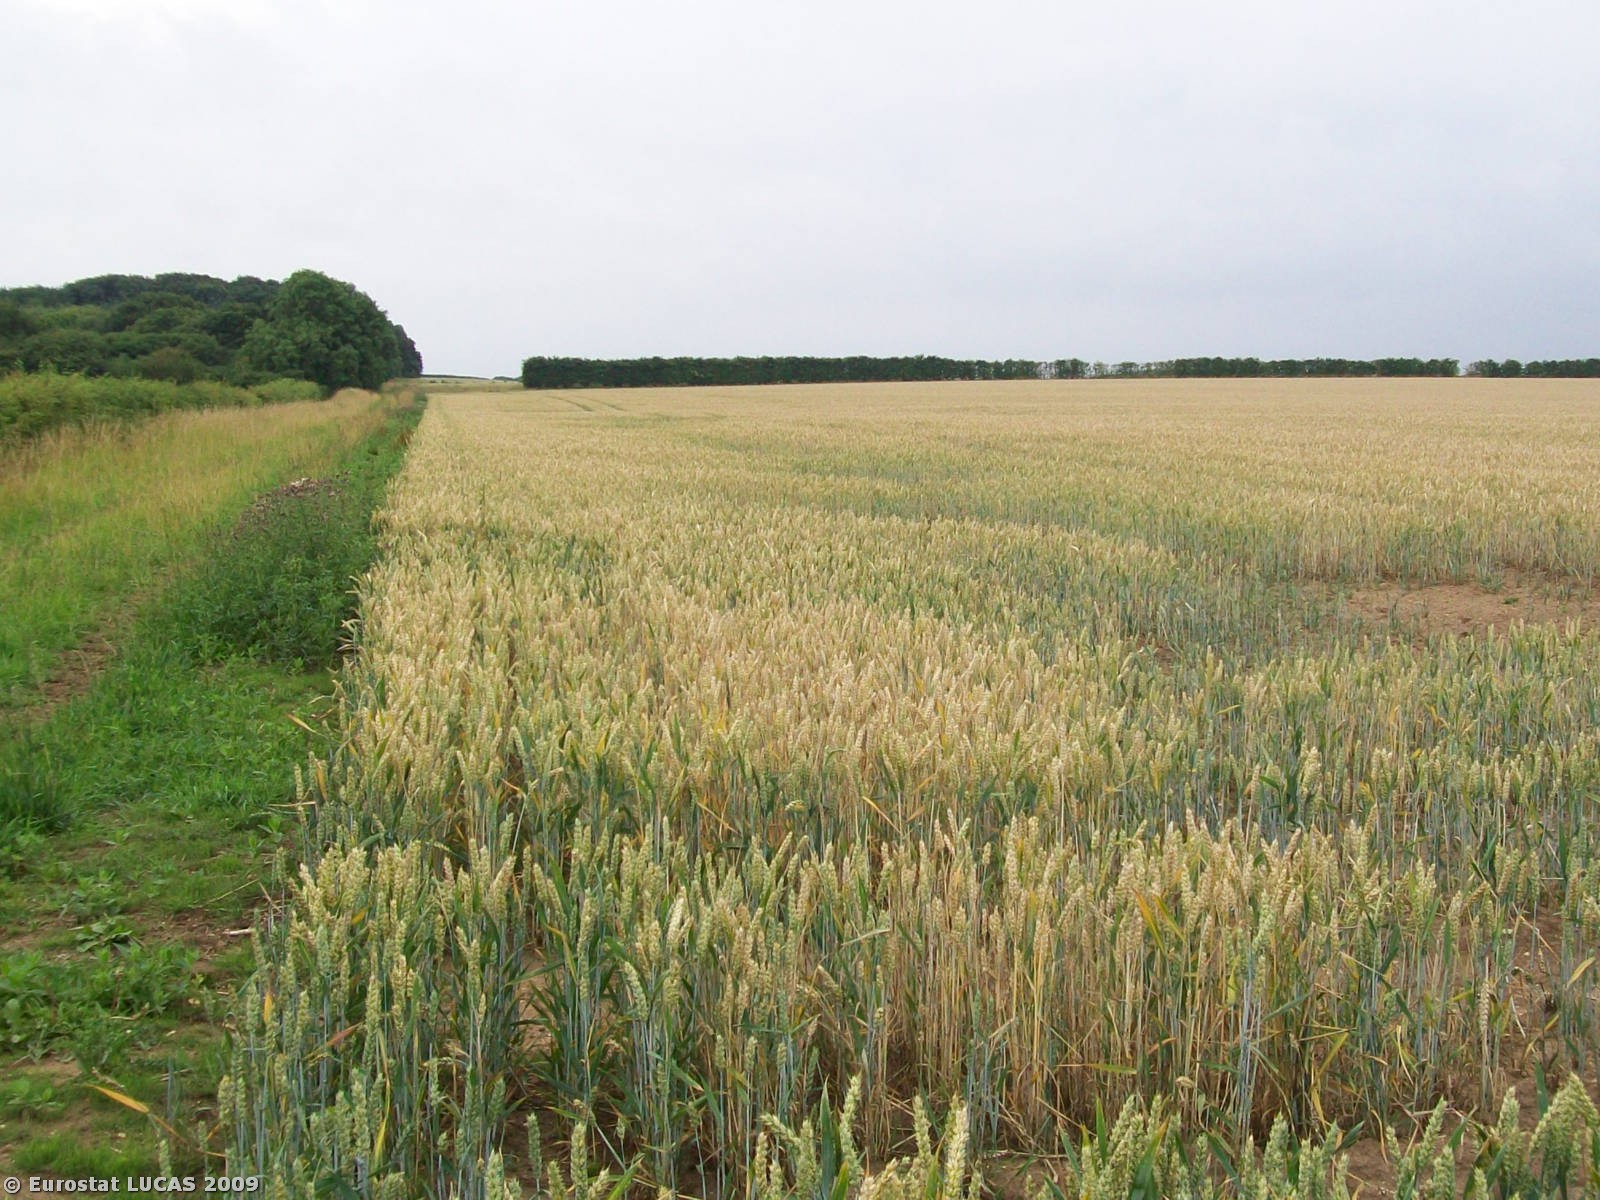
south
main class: Cropland
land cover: Common wheat
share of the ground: > 75 %
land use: Agriculture (excluding fallow land and kitchen gardens)
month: July
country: GB
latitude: 53.8706
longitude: -0.2694
